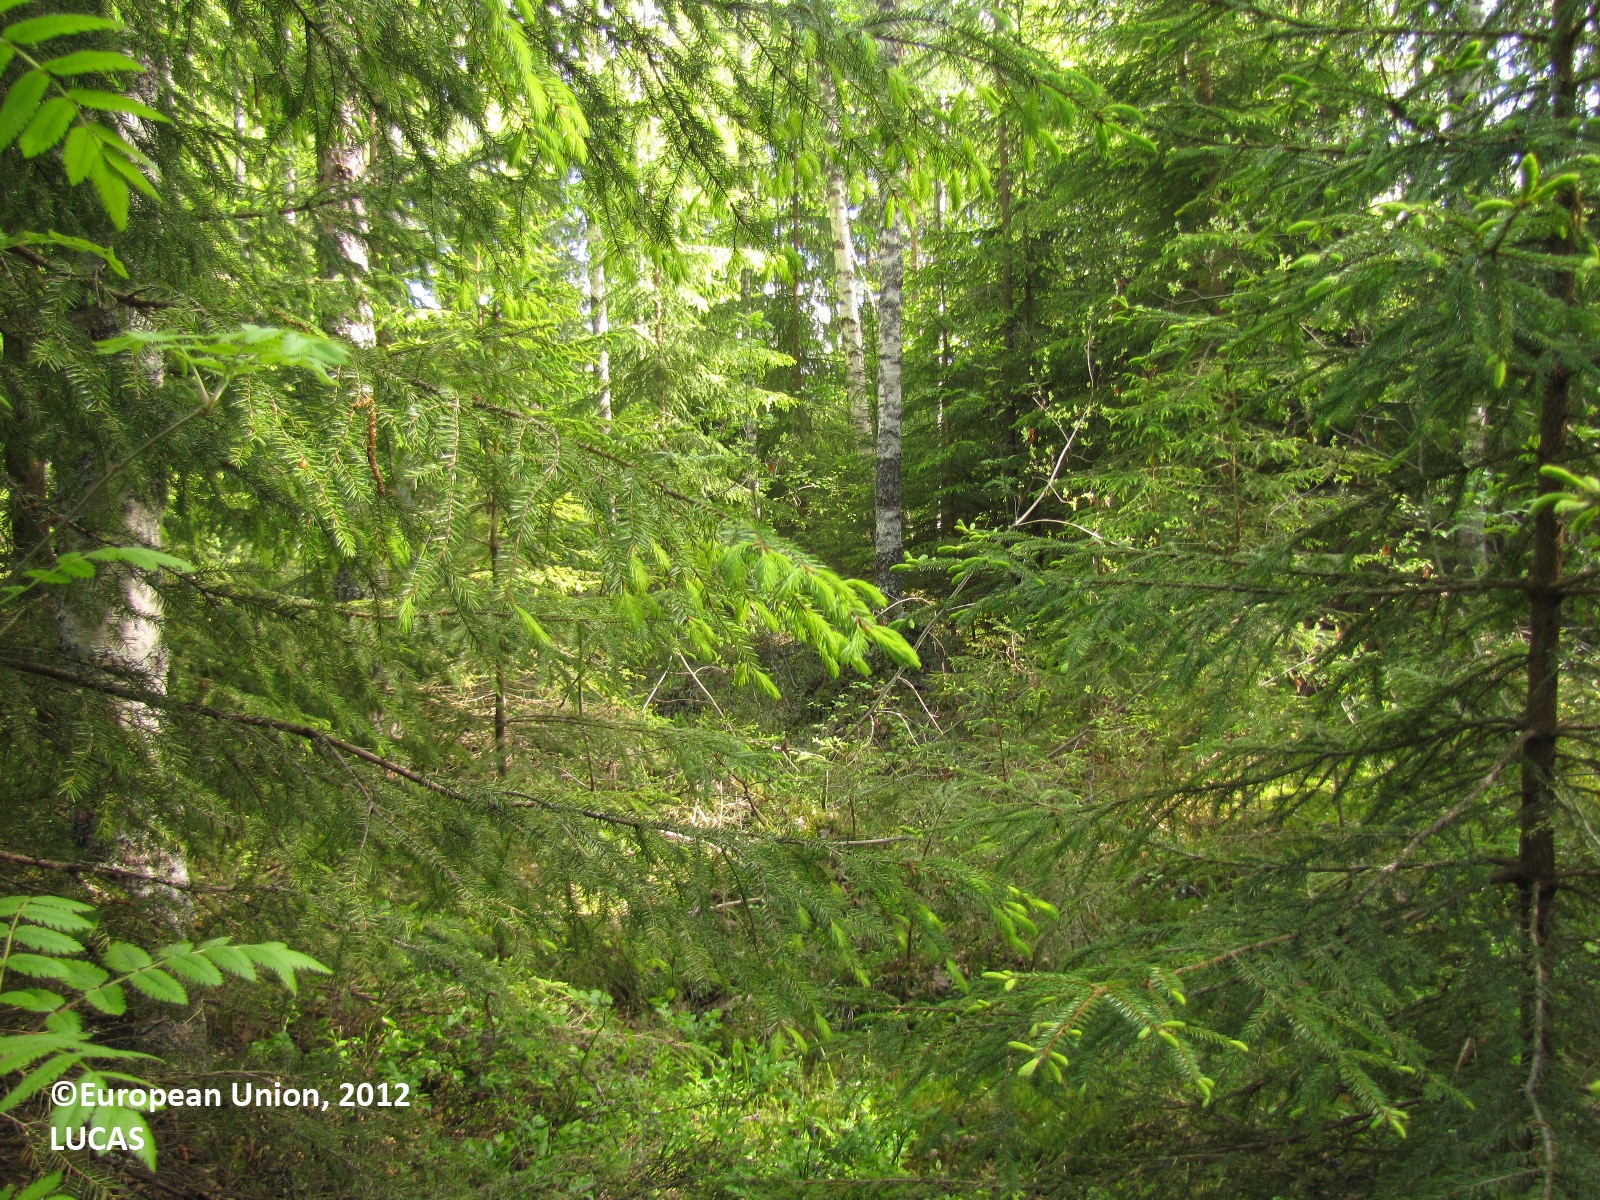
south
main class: Woodland
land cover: Other mixed woodland
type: boreal forest
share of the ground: > 75 %
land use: Forestry
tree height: > 5 m
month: June
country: FI
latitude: 61.4566
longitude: 23.0355
